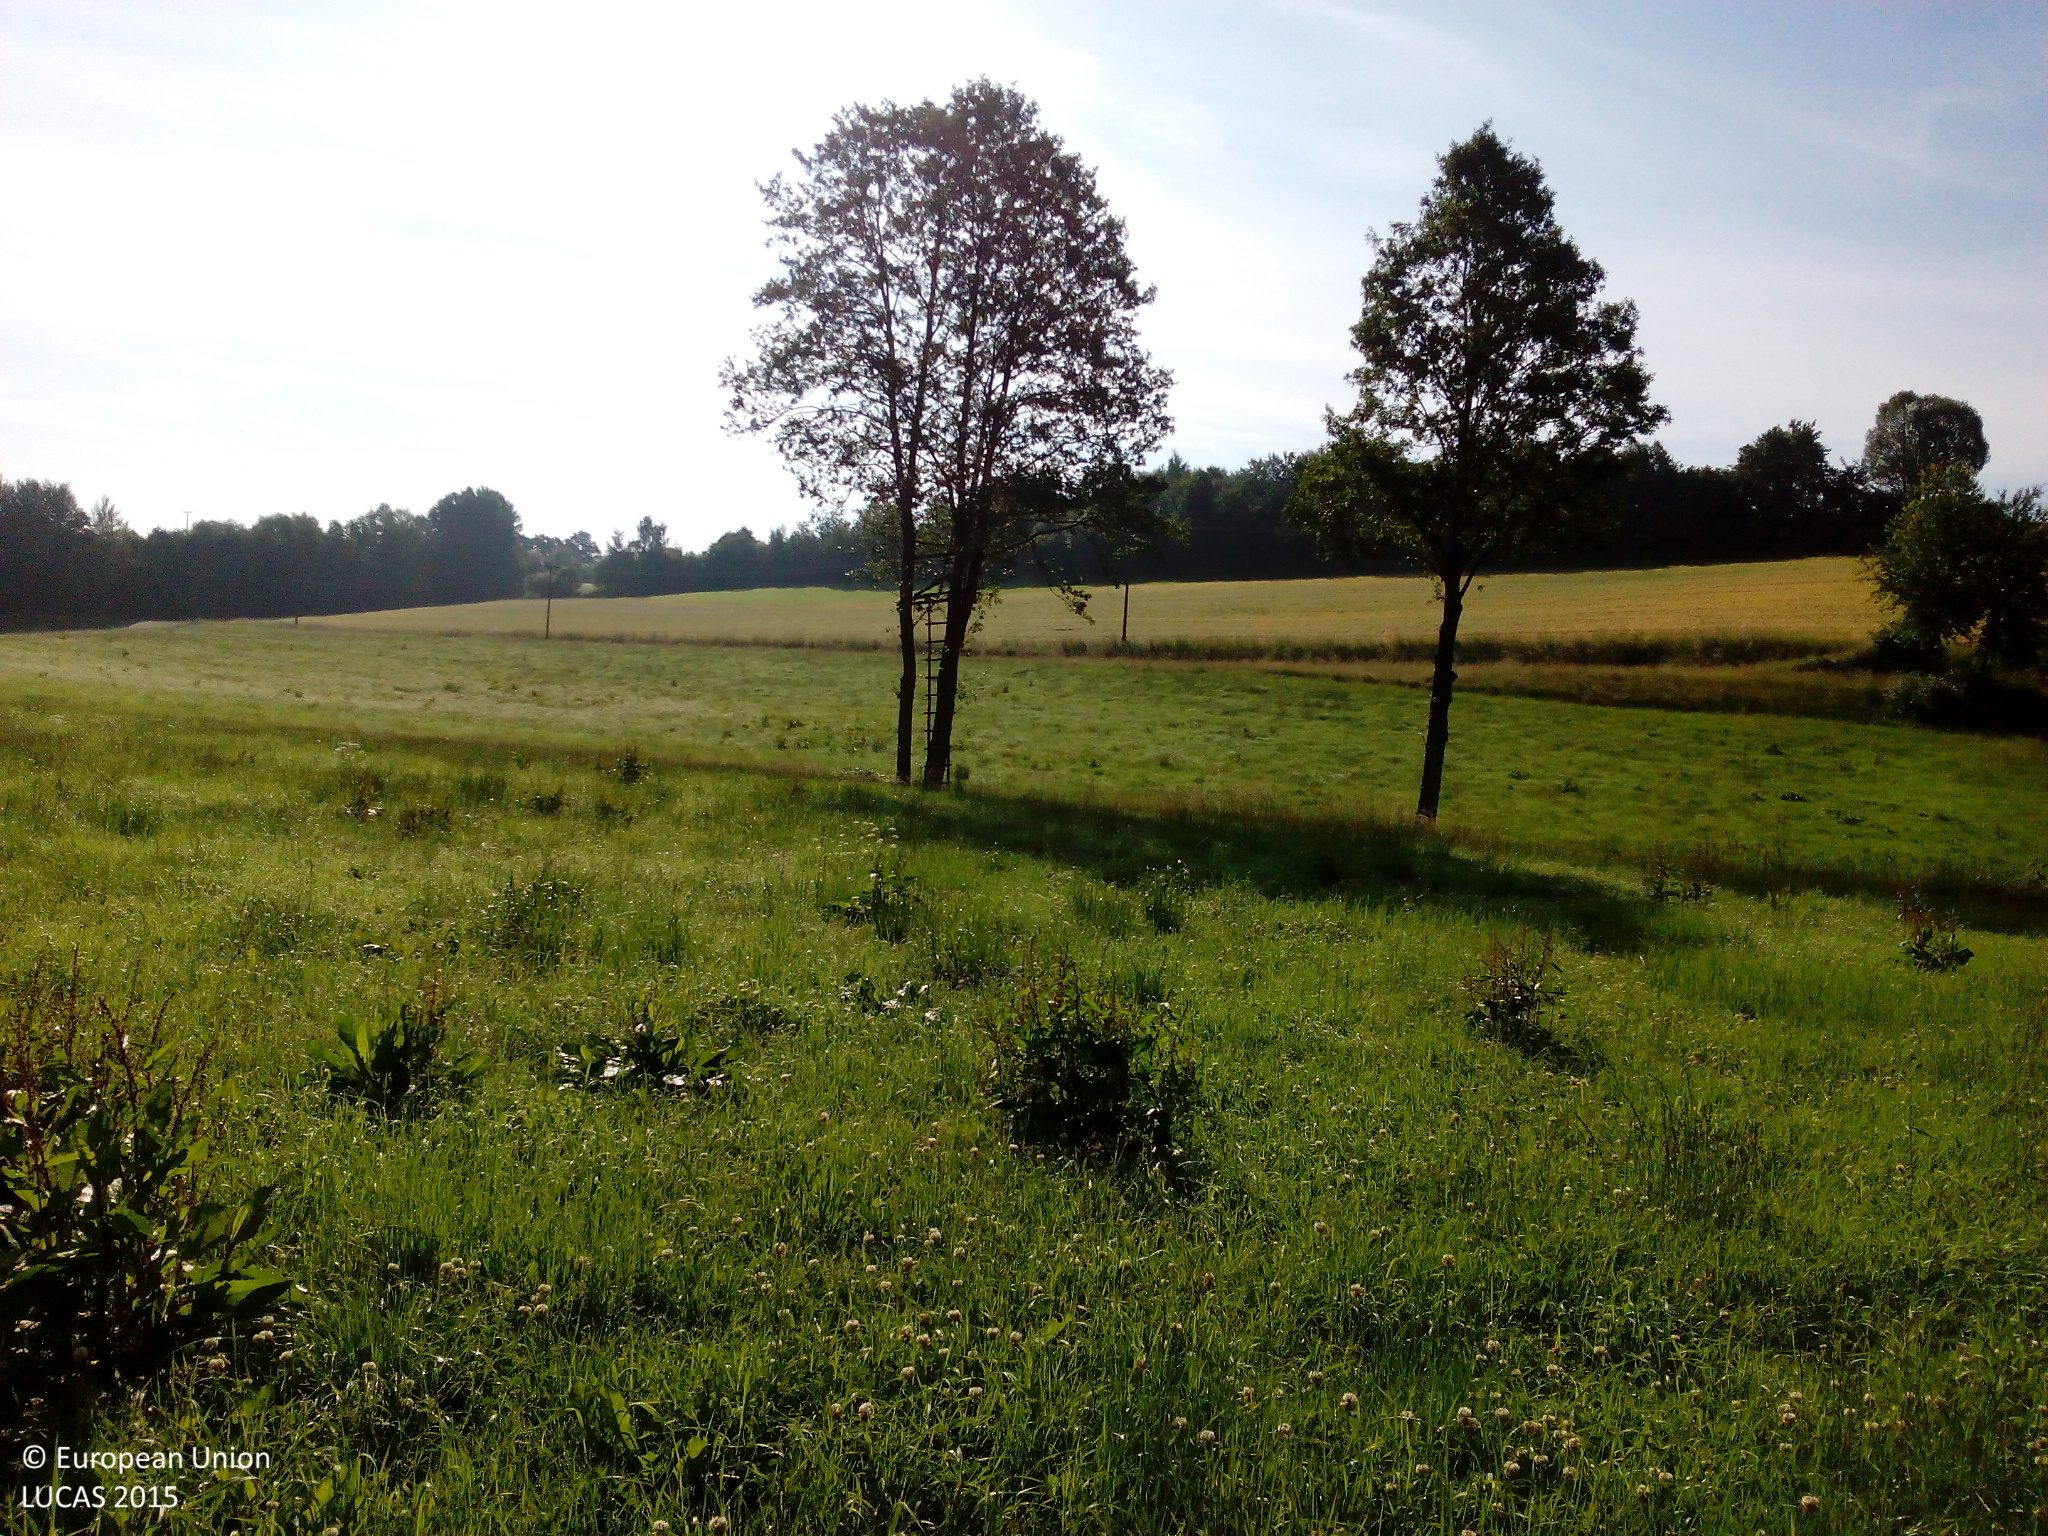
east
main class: Grassland
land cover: Grassland without tree/shrub cover
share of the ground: > 75 %
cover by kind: herbaceous plants 100 %
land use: Agriculture (excluding fallow land and kitchen gardens)
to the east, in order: Grassland without tree/shrub cover; Rivers and streams; Grassland without tree/shrub cover; Tracks; Ditches and canals; Grass margins; Electric lines; Barley
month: June
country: DE
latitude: 49.9974
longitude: 12.3852
